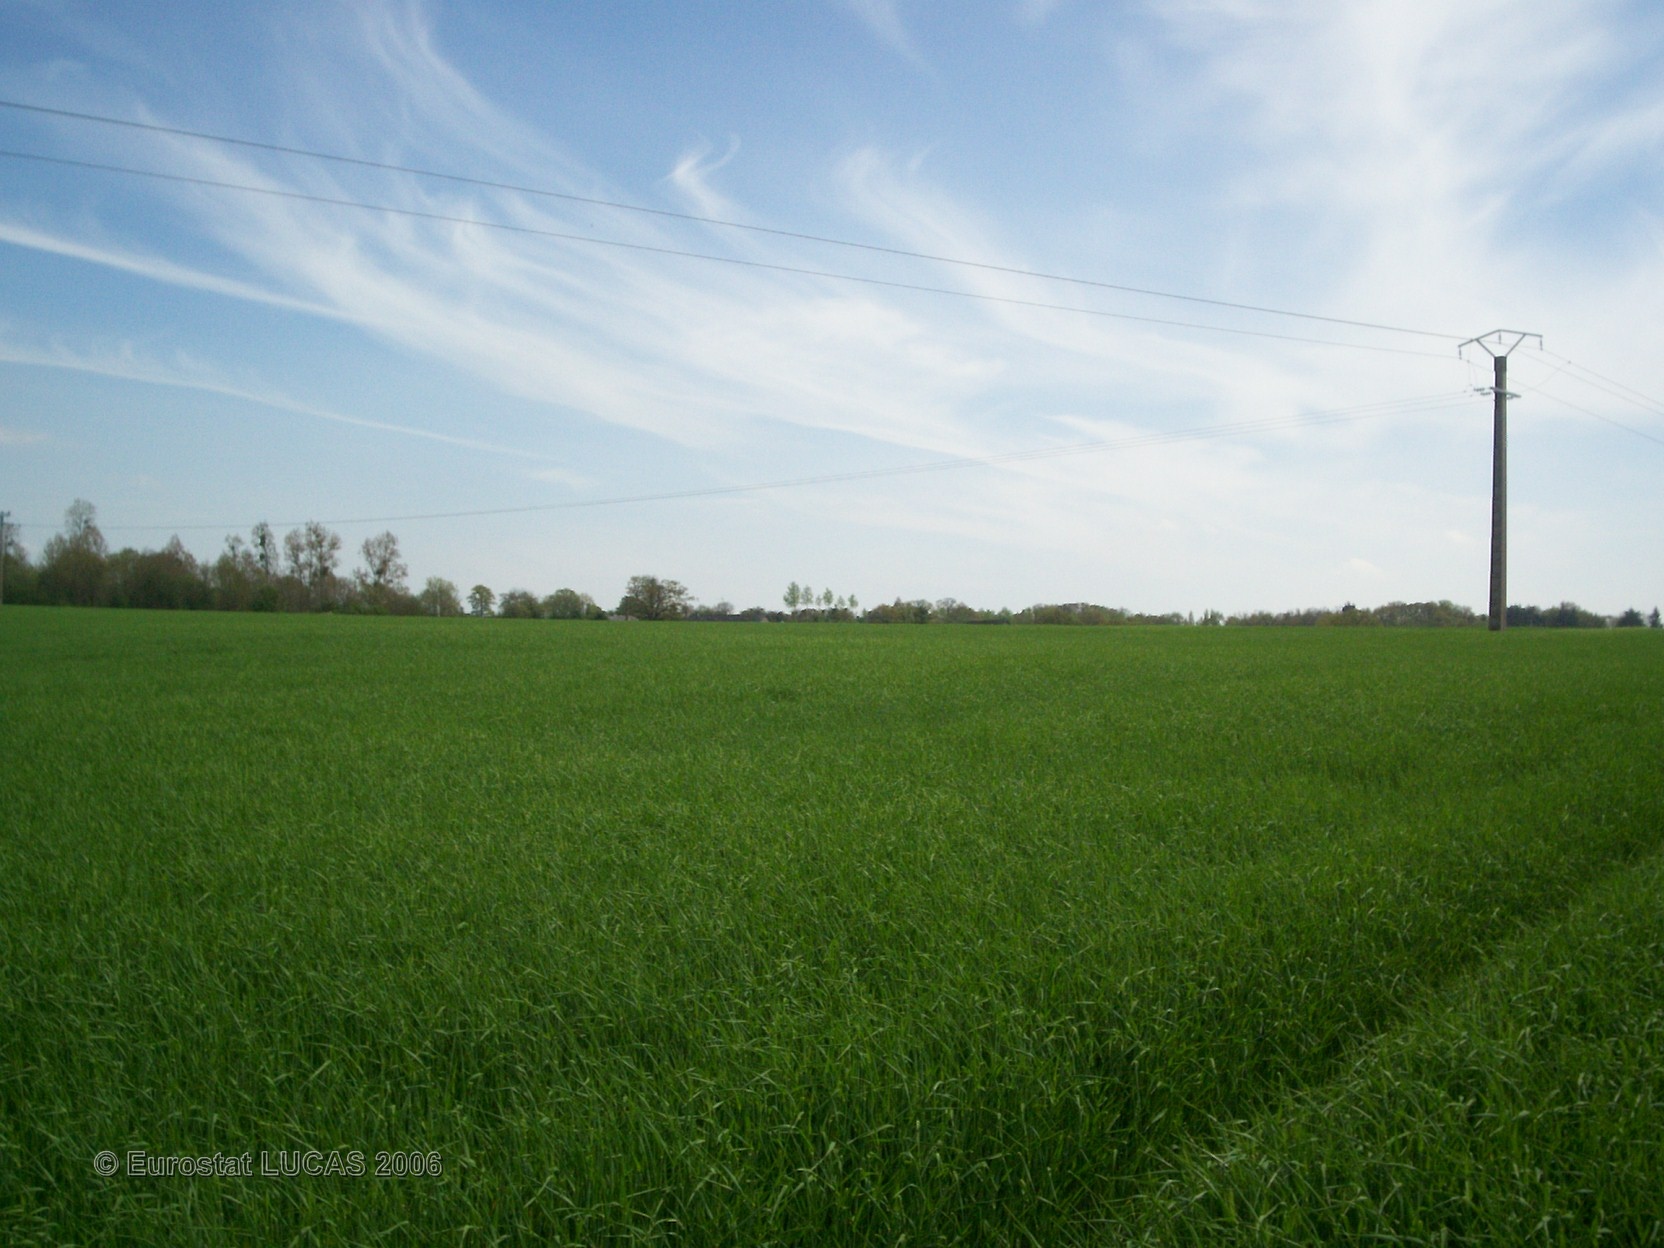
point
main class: Cropland
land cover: Barley
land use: Agriculture (excluding fallow land and kitchen gardens)
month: May
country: FR
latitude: 48.1961
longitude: -0.6504
